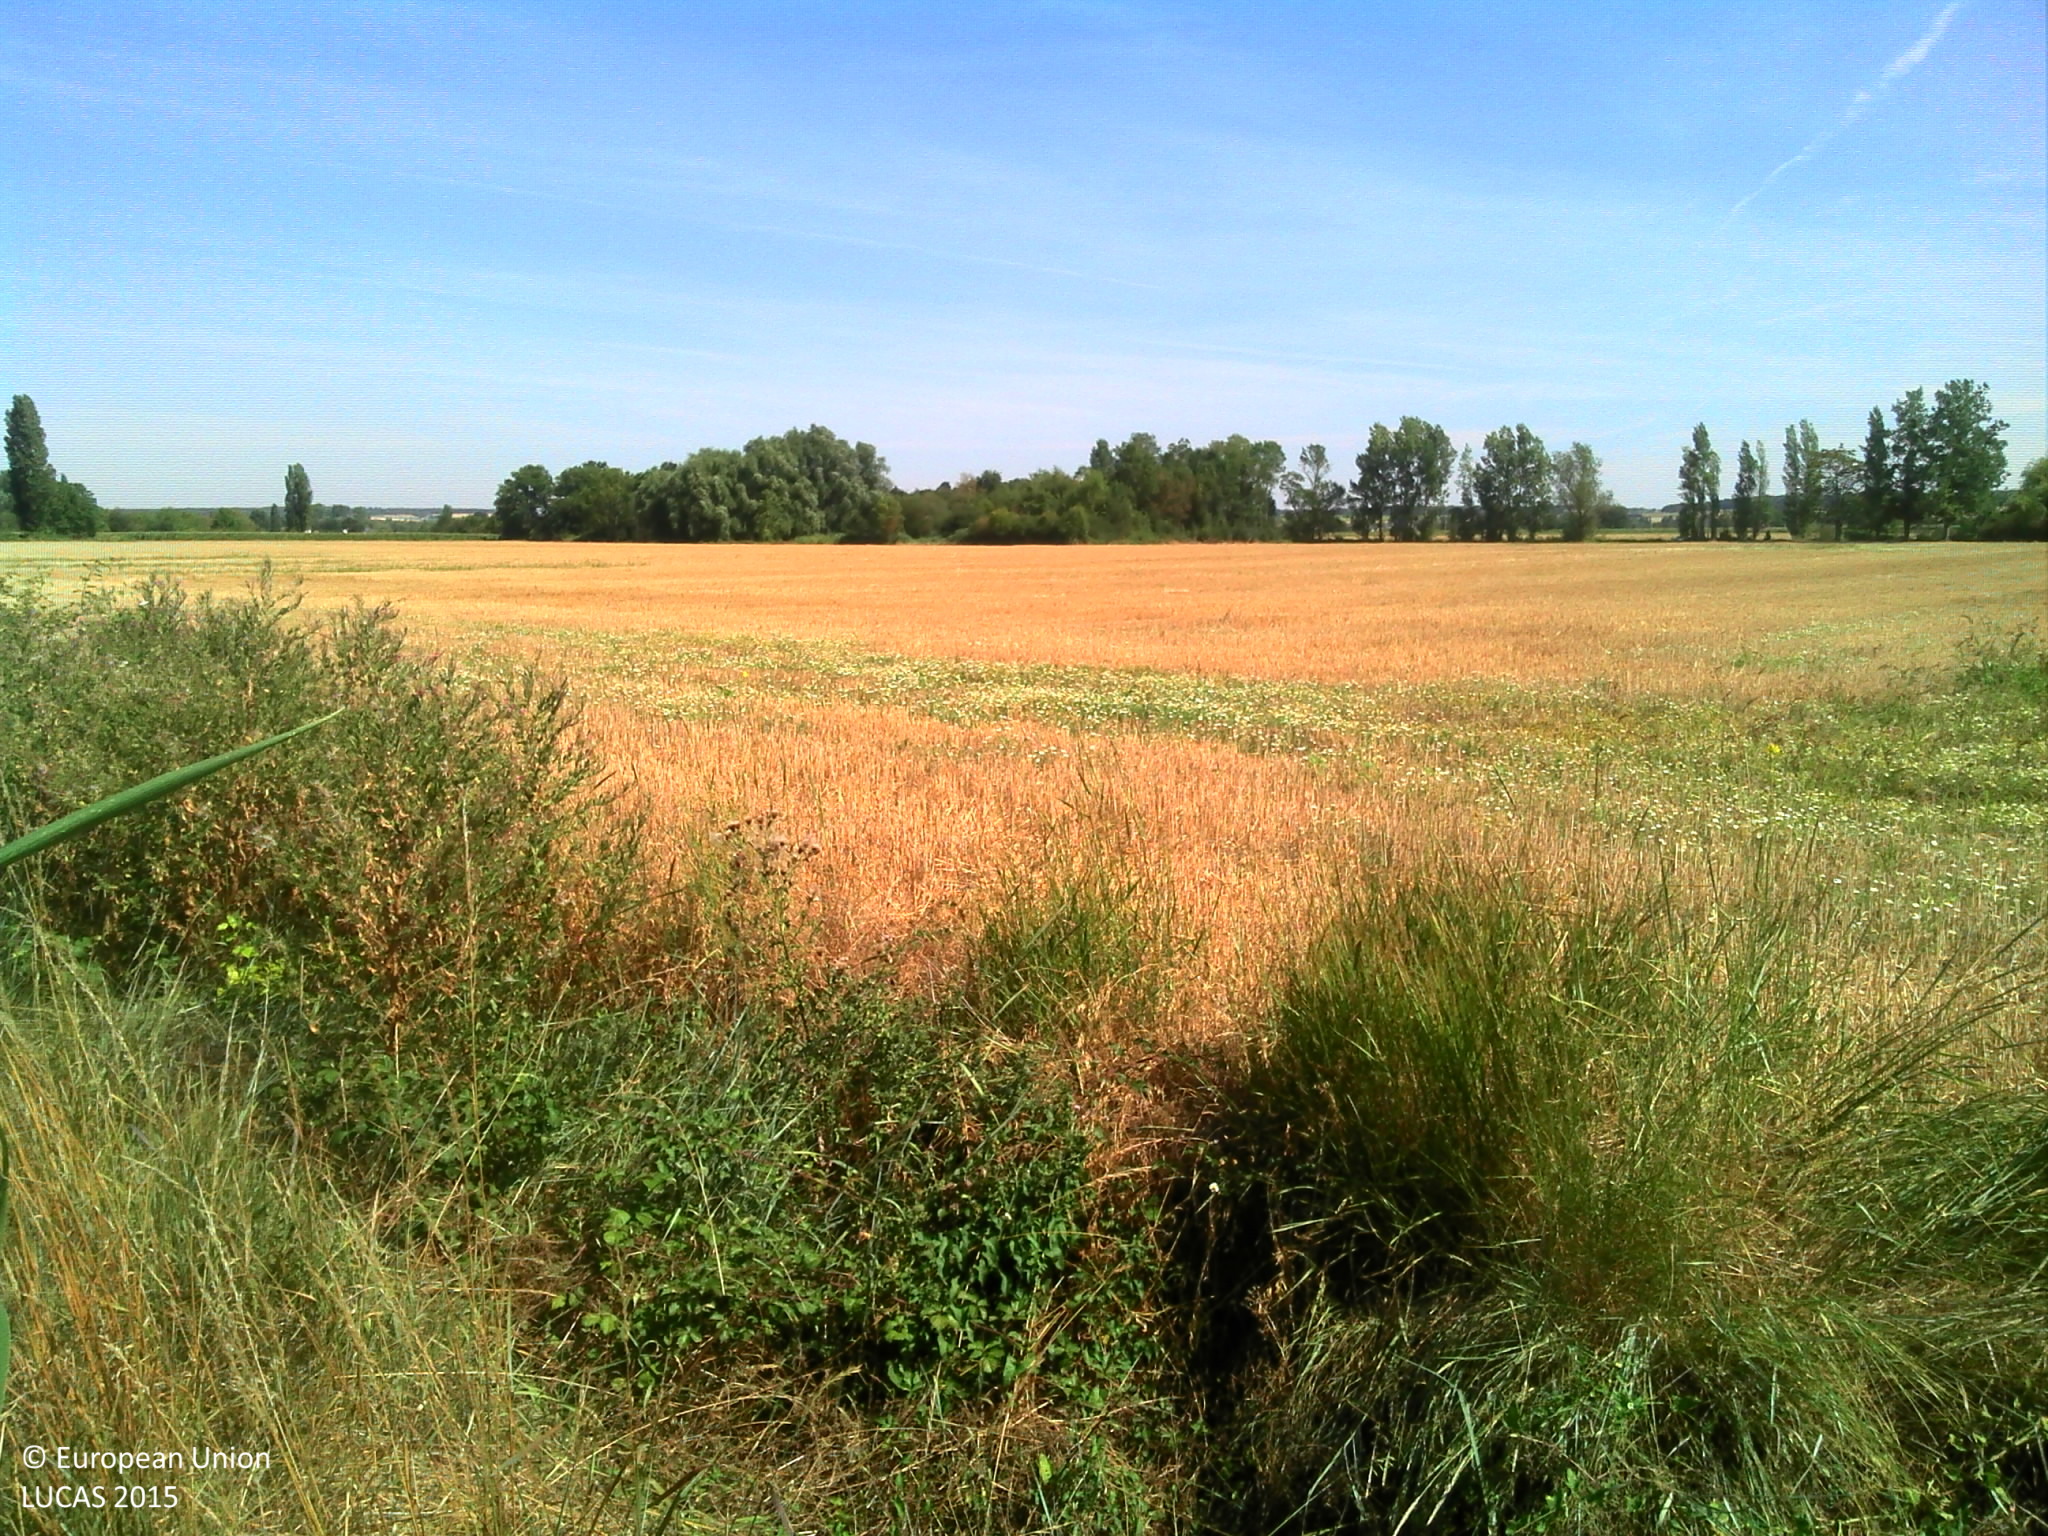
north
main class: Cropland
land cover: Maize
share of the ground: > 75 %
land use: Agriculture (excluding fallow land and kitchen gardens)
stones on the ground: < 10 %
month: July
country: FR
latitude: 47.1016
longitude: 0.4534
